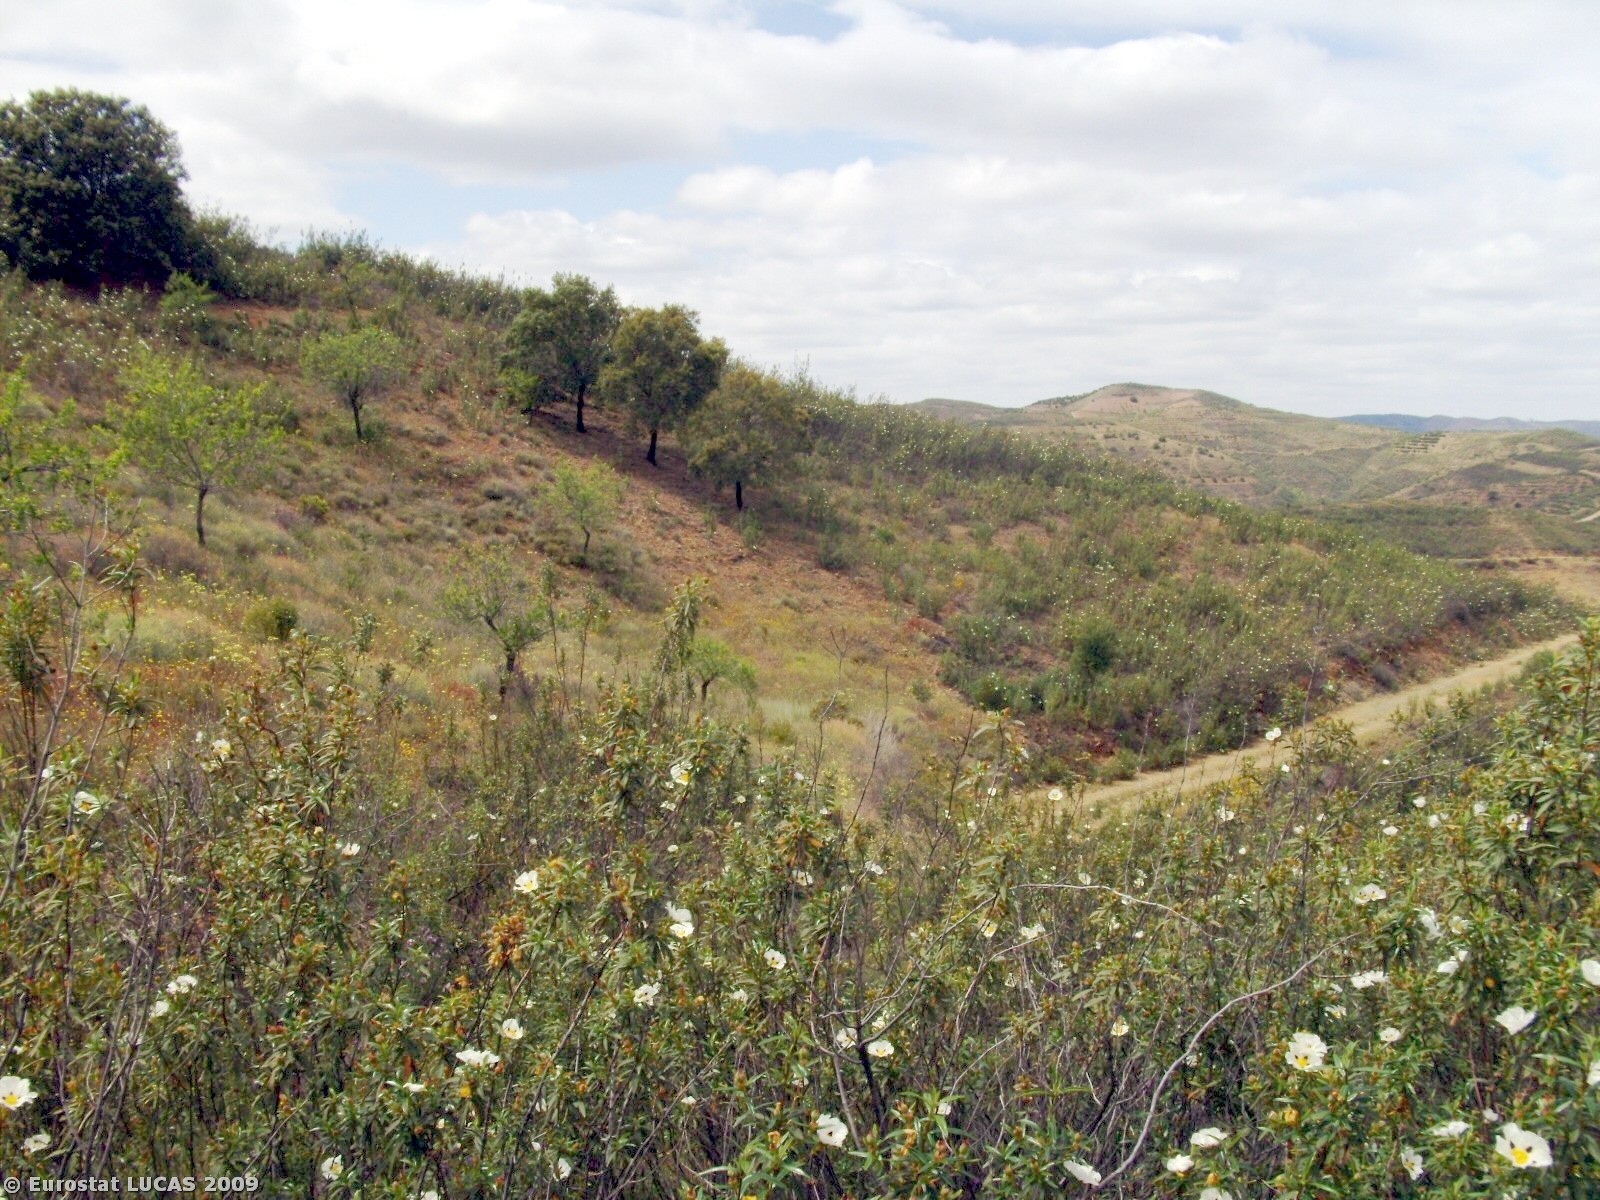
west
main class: Bare land
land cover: Bare land
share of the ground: > 75 %
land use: Unused
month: April
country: PT
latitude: 37.3050
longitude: -7.6425
